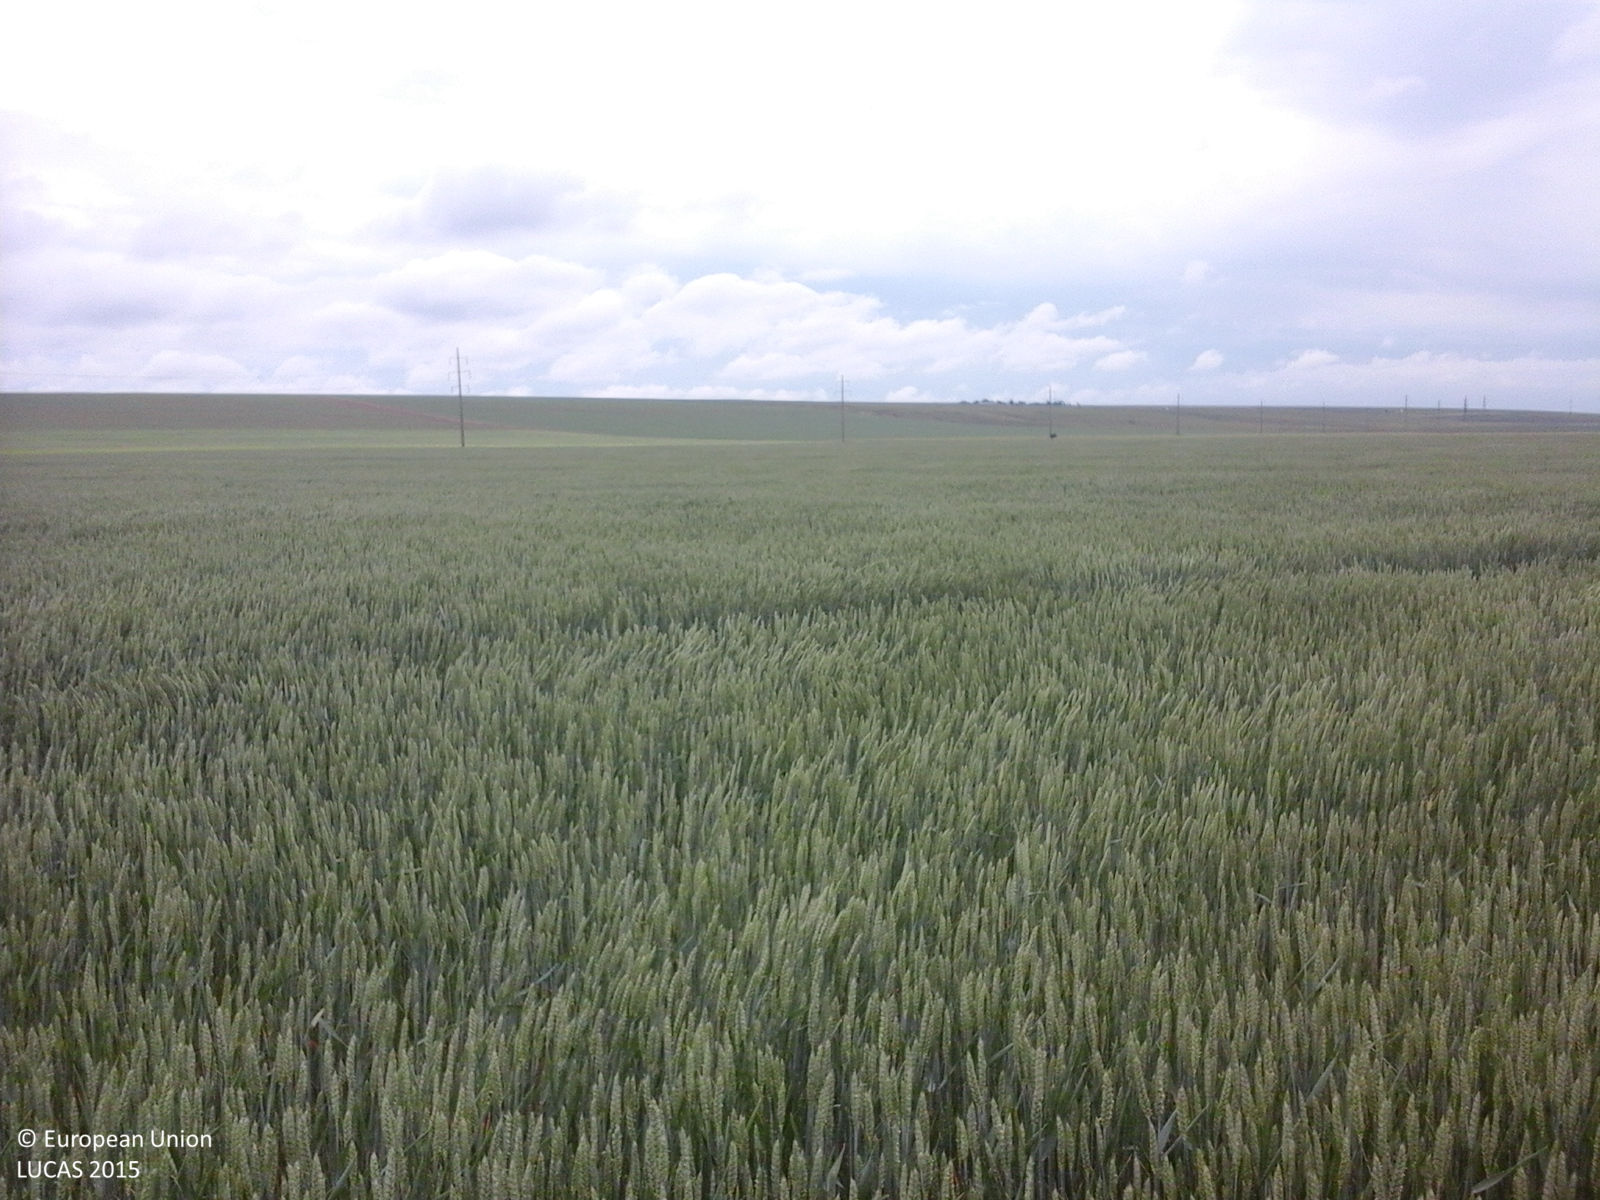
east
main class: Cropland
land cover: Common wheat
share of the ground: > 75 %
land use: Agriculture (excluding fallow land and kitchen gardens)
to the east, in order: Common wheat
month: June
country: RO
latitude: 47.1233
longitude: 26.6870
